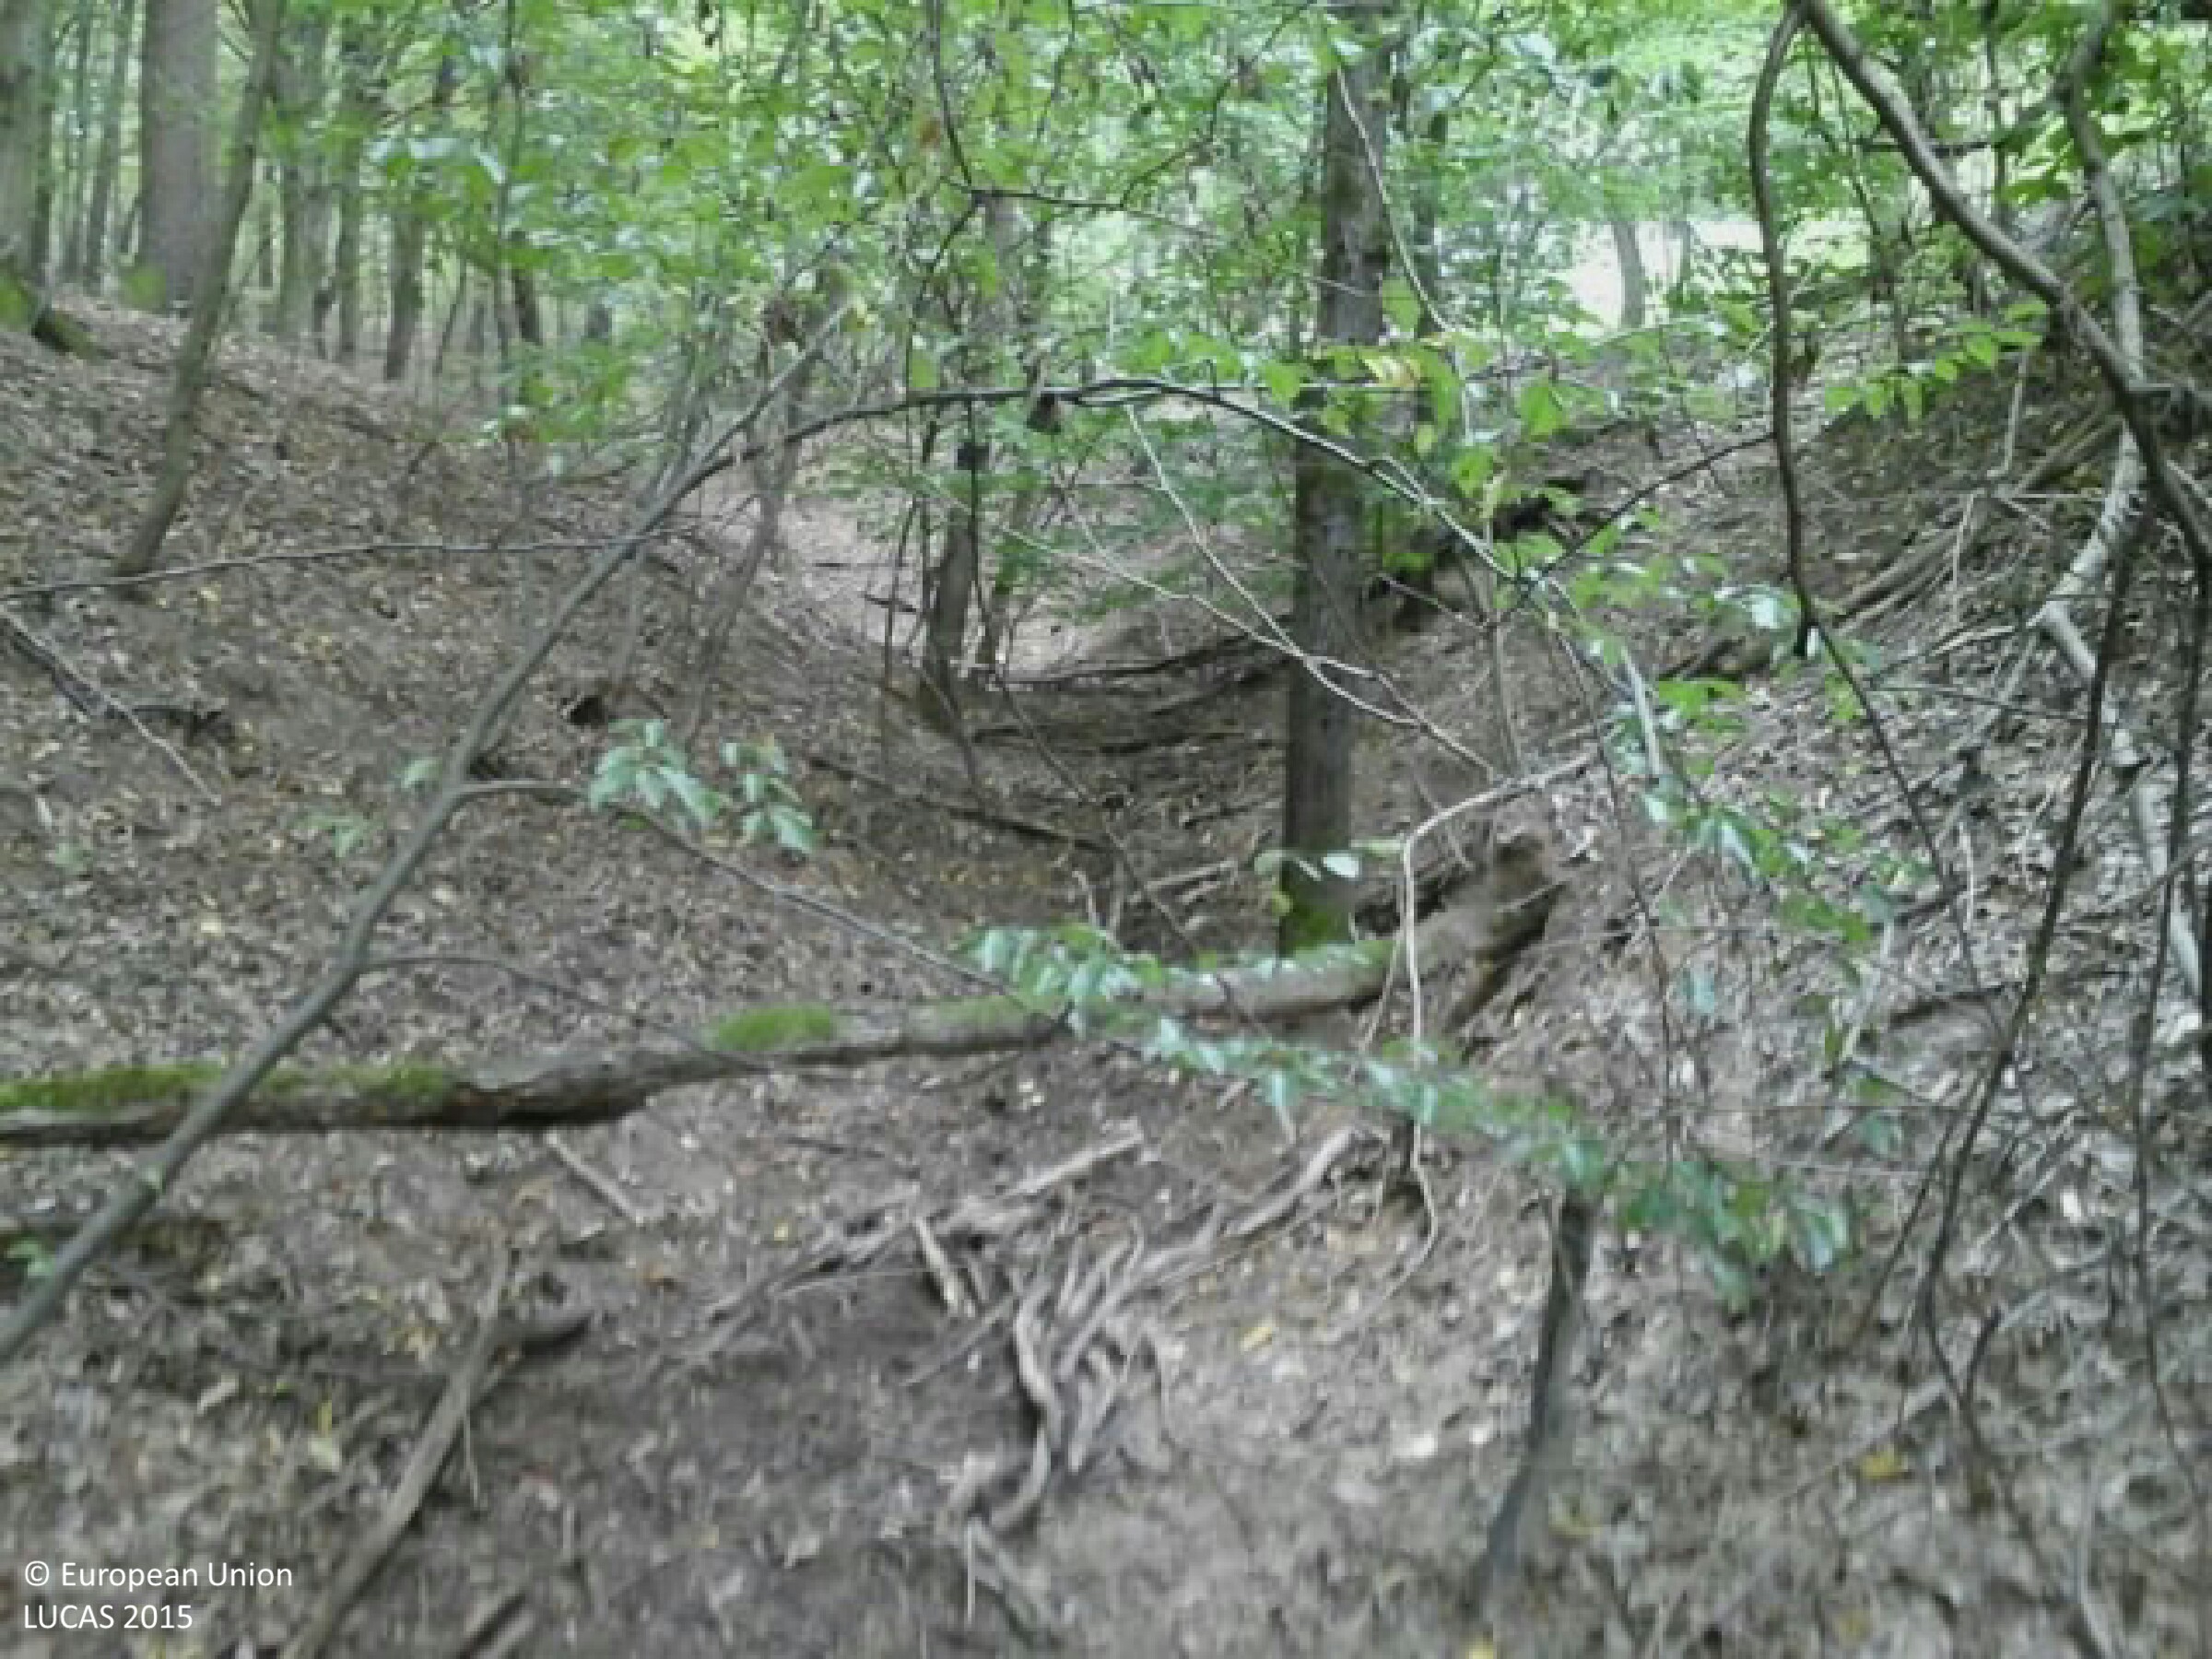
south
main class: Woodland
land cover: Broadleaved woodland
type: mesophytic deciduous forest
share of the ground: > 75 %
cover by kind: broadleaved forest trees 100 %
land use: Forestry
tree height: > 5 m
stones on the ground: < 10 %
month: September
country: HU
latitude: 48.1284
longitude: 19.8214
